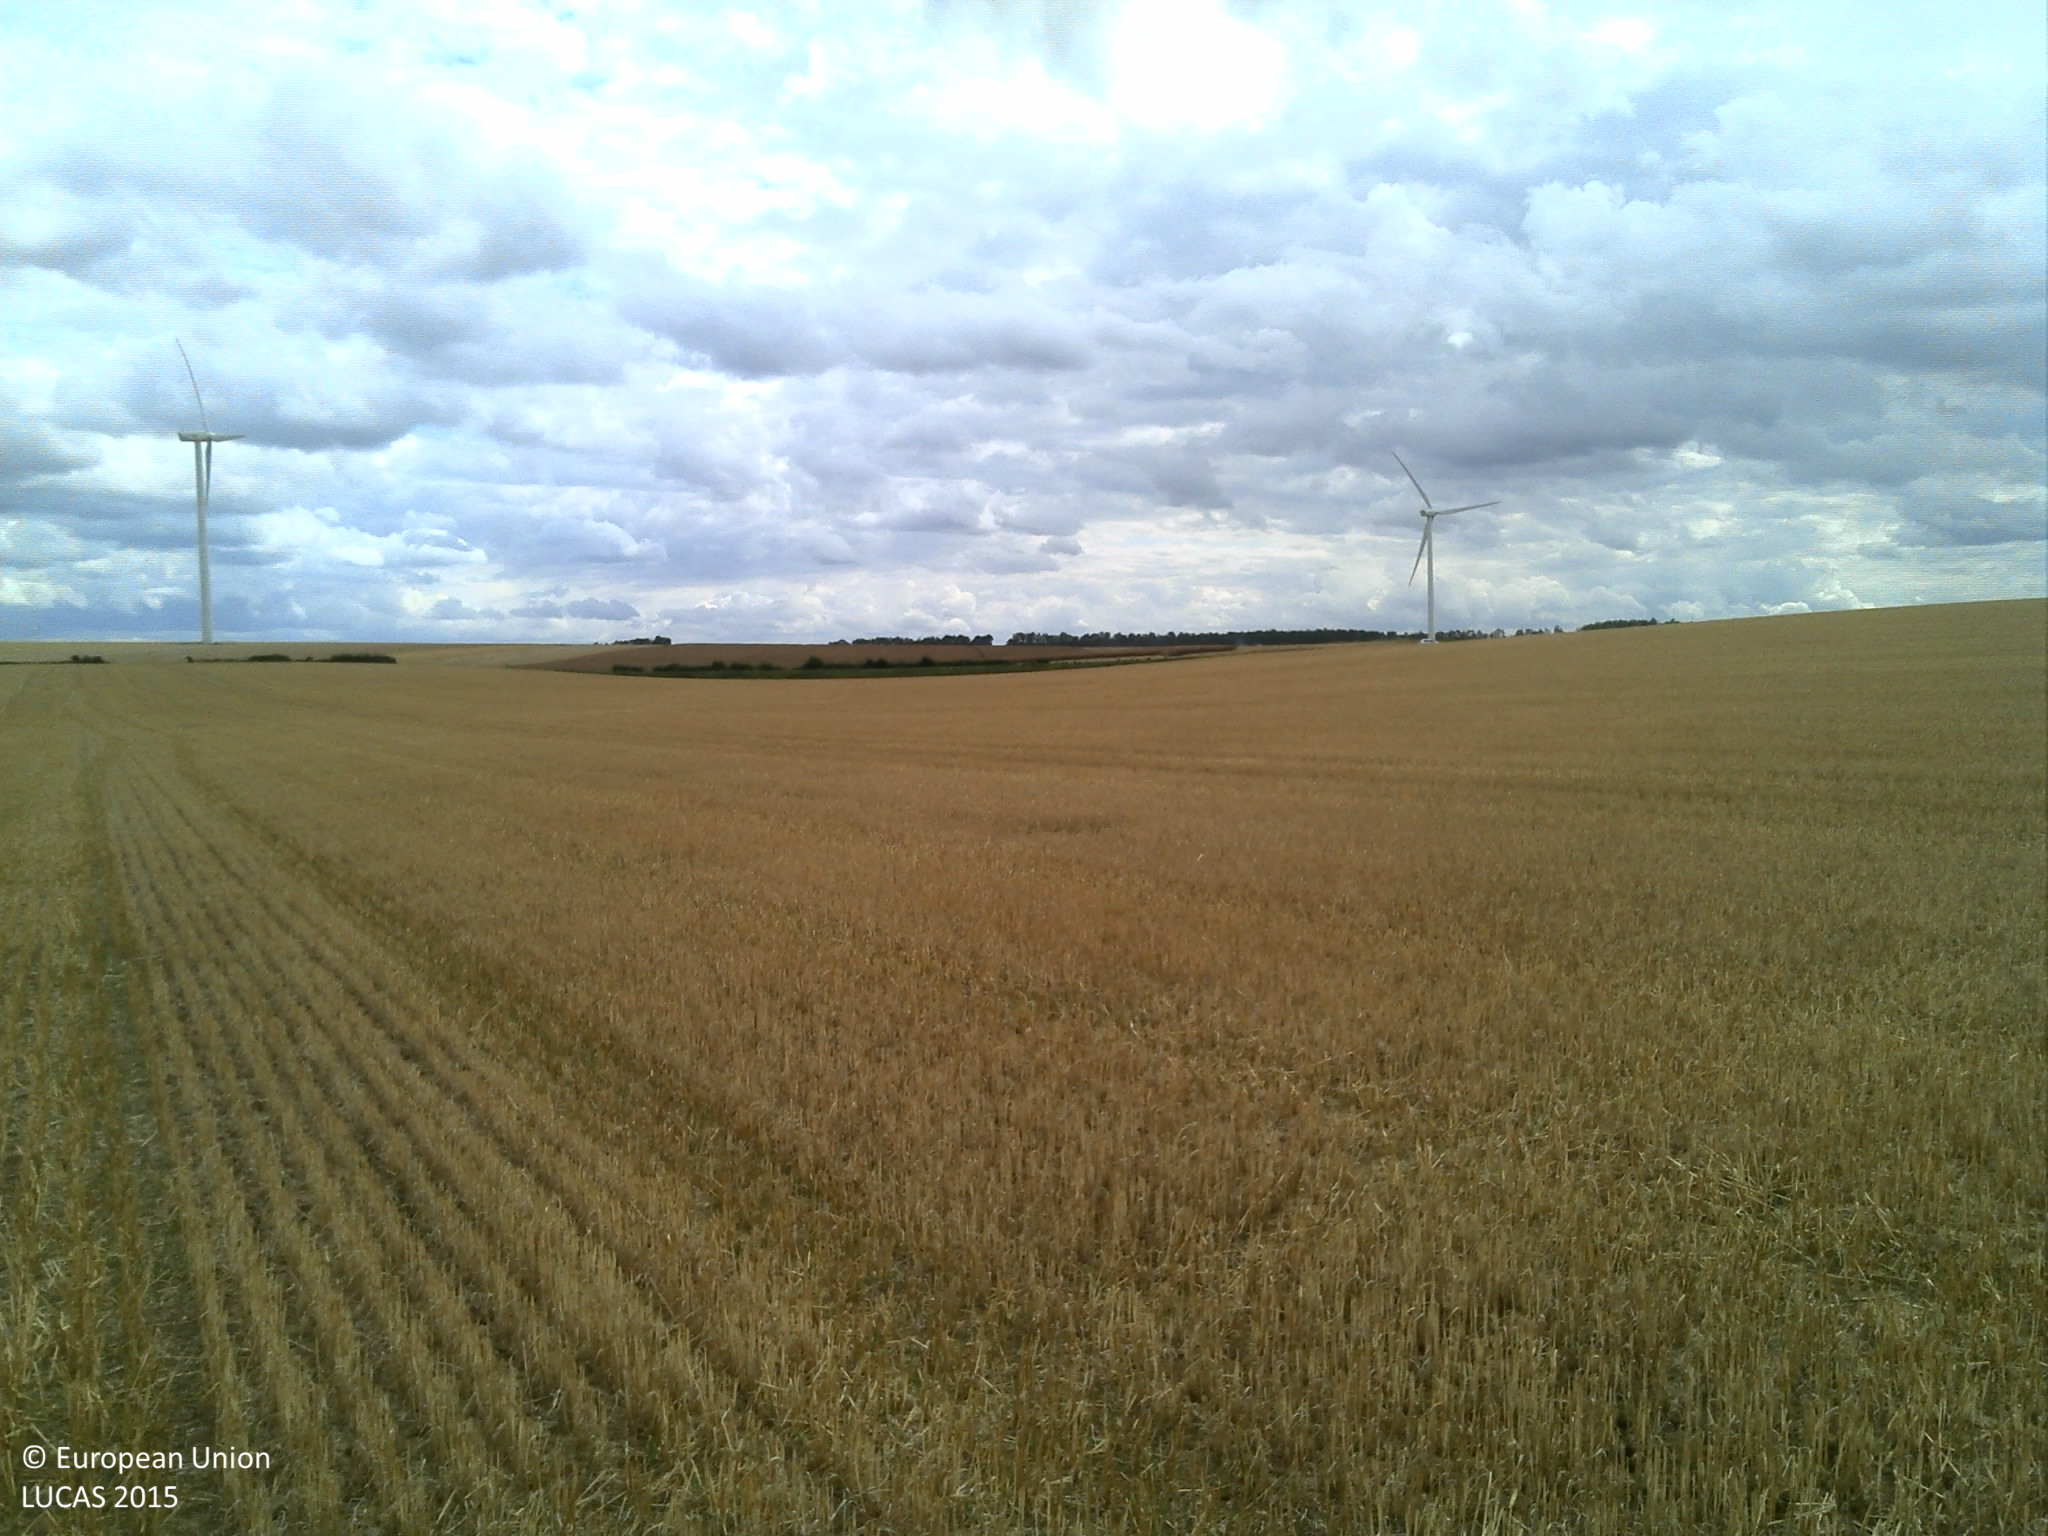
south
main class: Cropland
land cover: Barley
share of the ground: 50 - 75 %
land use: Agriculture (excluding fallow land and kitchen gardens)
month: July
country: FR
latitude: 49.3501
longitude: 4.5314
